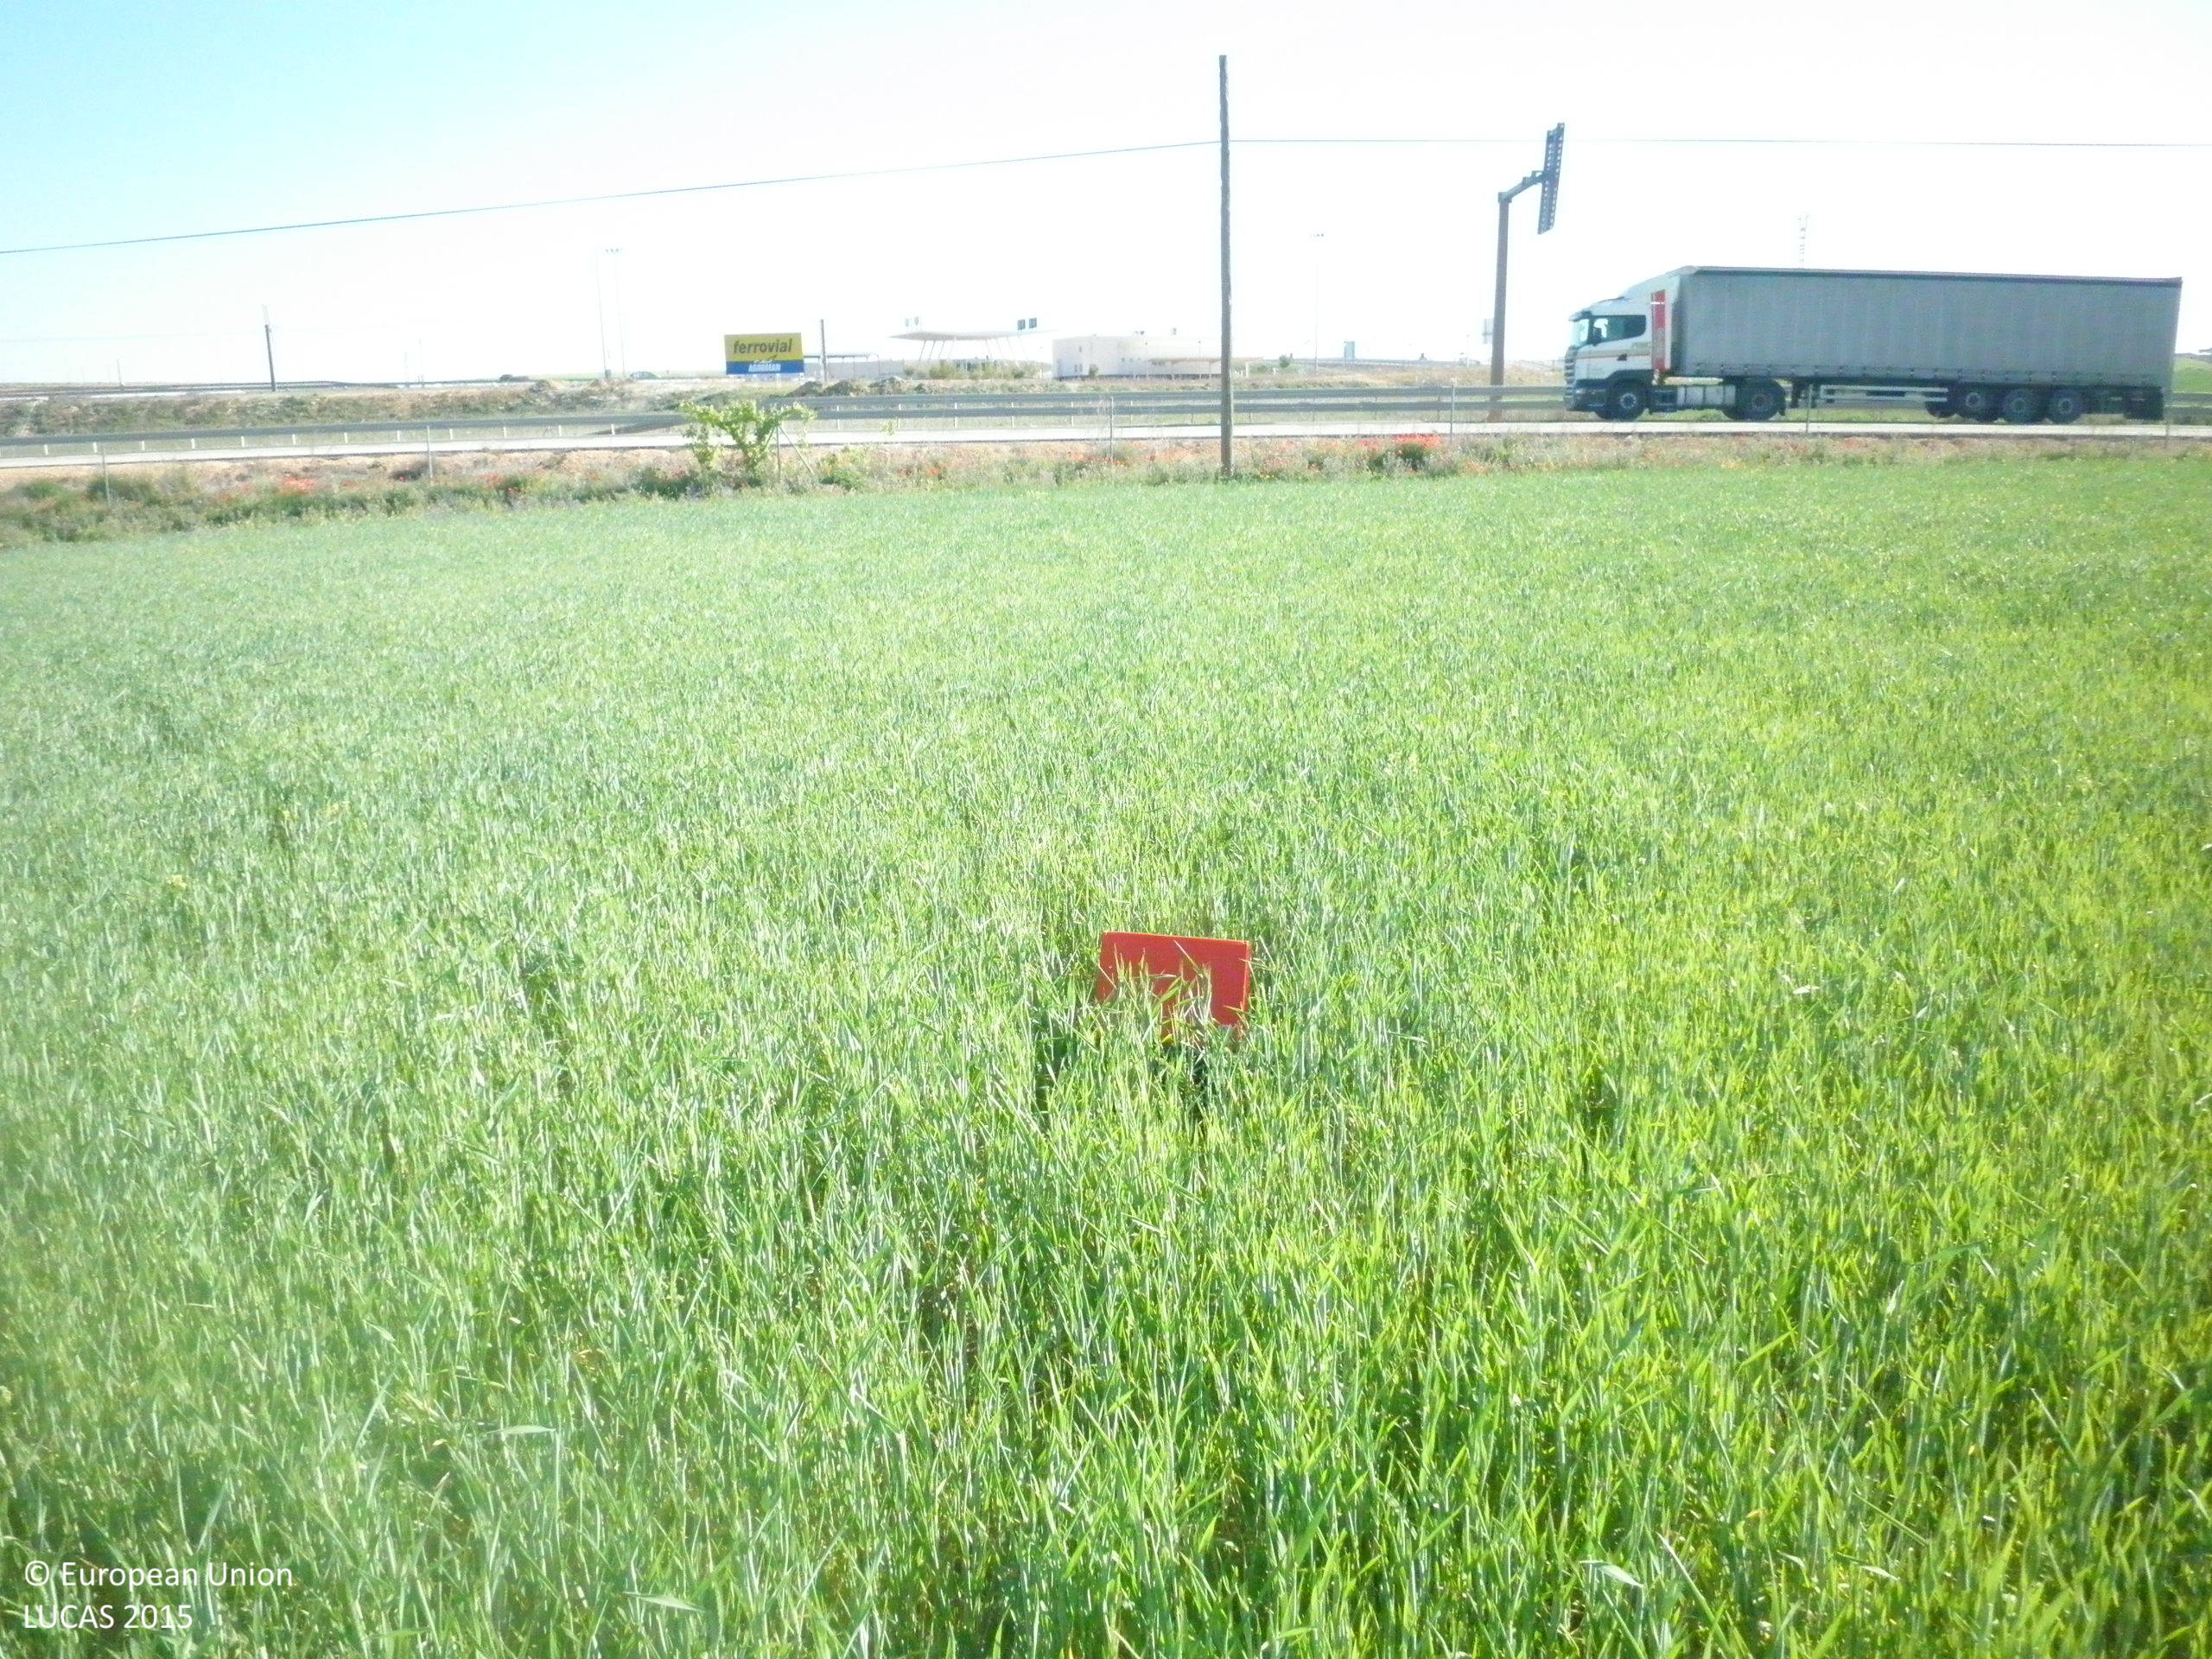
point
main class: Cropland
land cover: Durum wheat
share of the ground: > 75 %
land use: Agriculture (excluding fallow land and kitchen gardens)
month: May
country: ES
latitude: 39.4724
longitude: -2.7193
